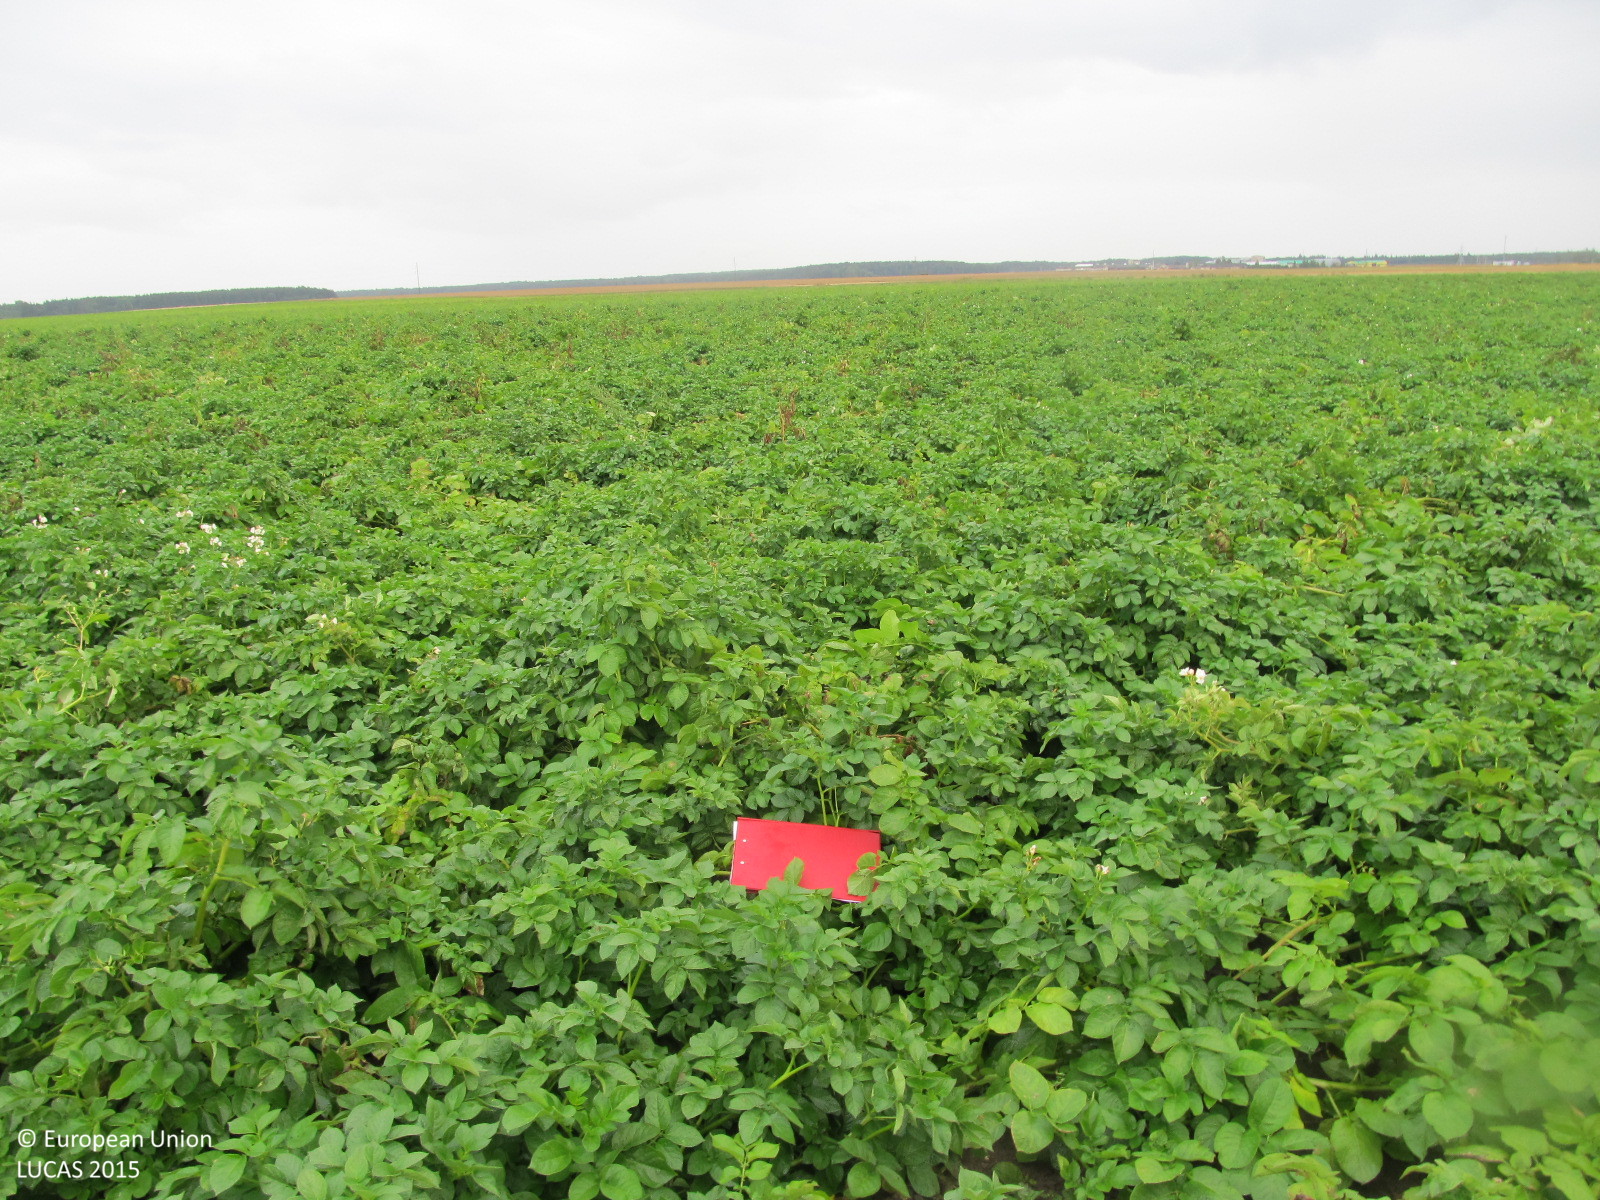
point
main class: Cropland
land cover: Potatoes
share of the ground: > 75 %
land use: Agriculture (excluding fallow land and kitchen gardens)
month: September
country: LT
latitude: 56.1177
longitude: 23.2444
